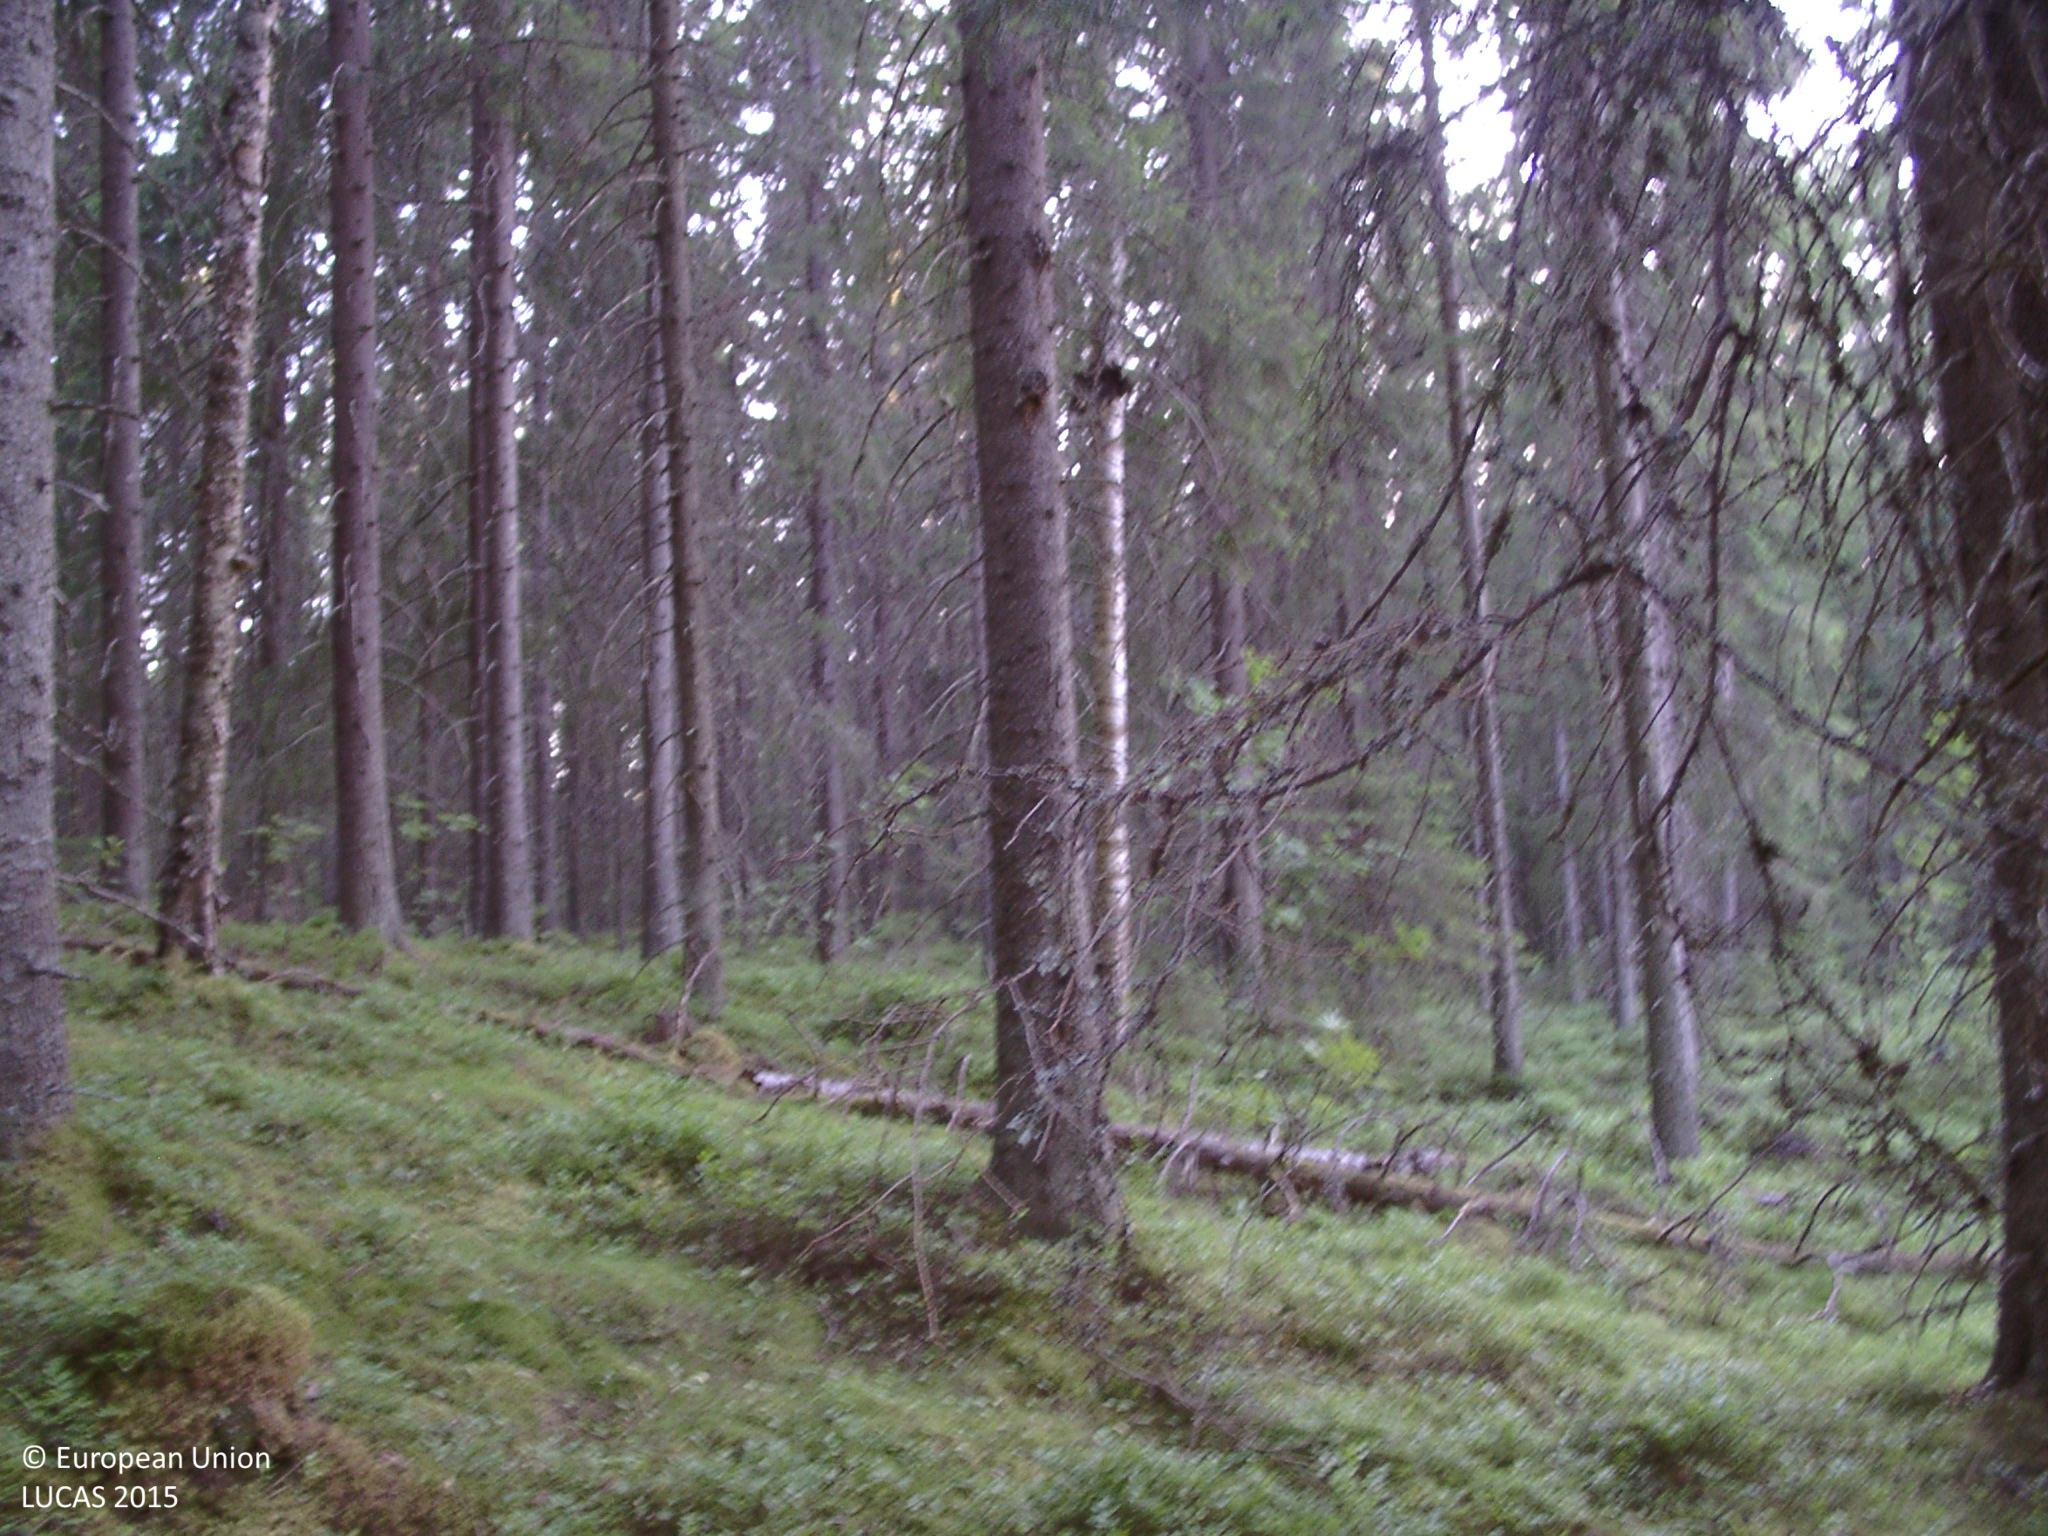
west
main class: Woodland
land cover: Spruce dominated coniferous woodland
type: boreal forest
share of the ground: > 75 %
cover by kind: coniferous forest trees 60 %, broadleaved forest trees 15 %, shrubs 10 %, lichens and mosses 10 %, herbaceous plants 5 %
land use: Forestry
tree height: > 5 m
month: July
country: FI
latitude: 62.0938
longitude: 25.5344
